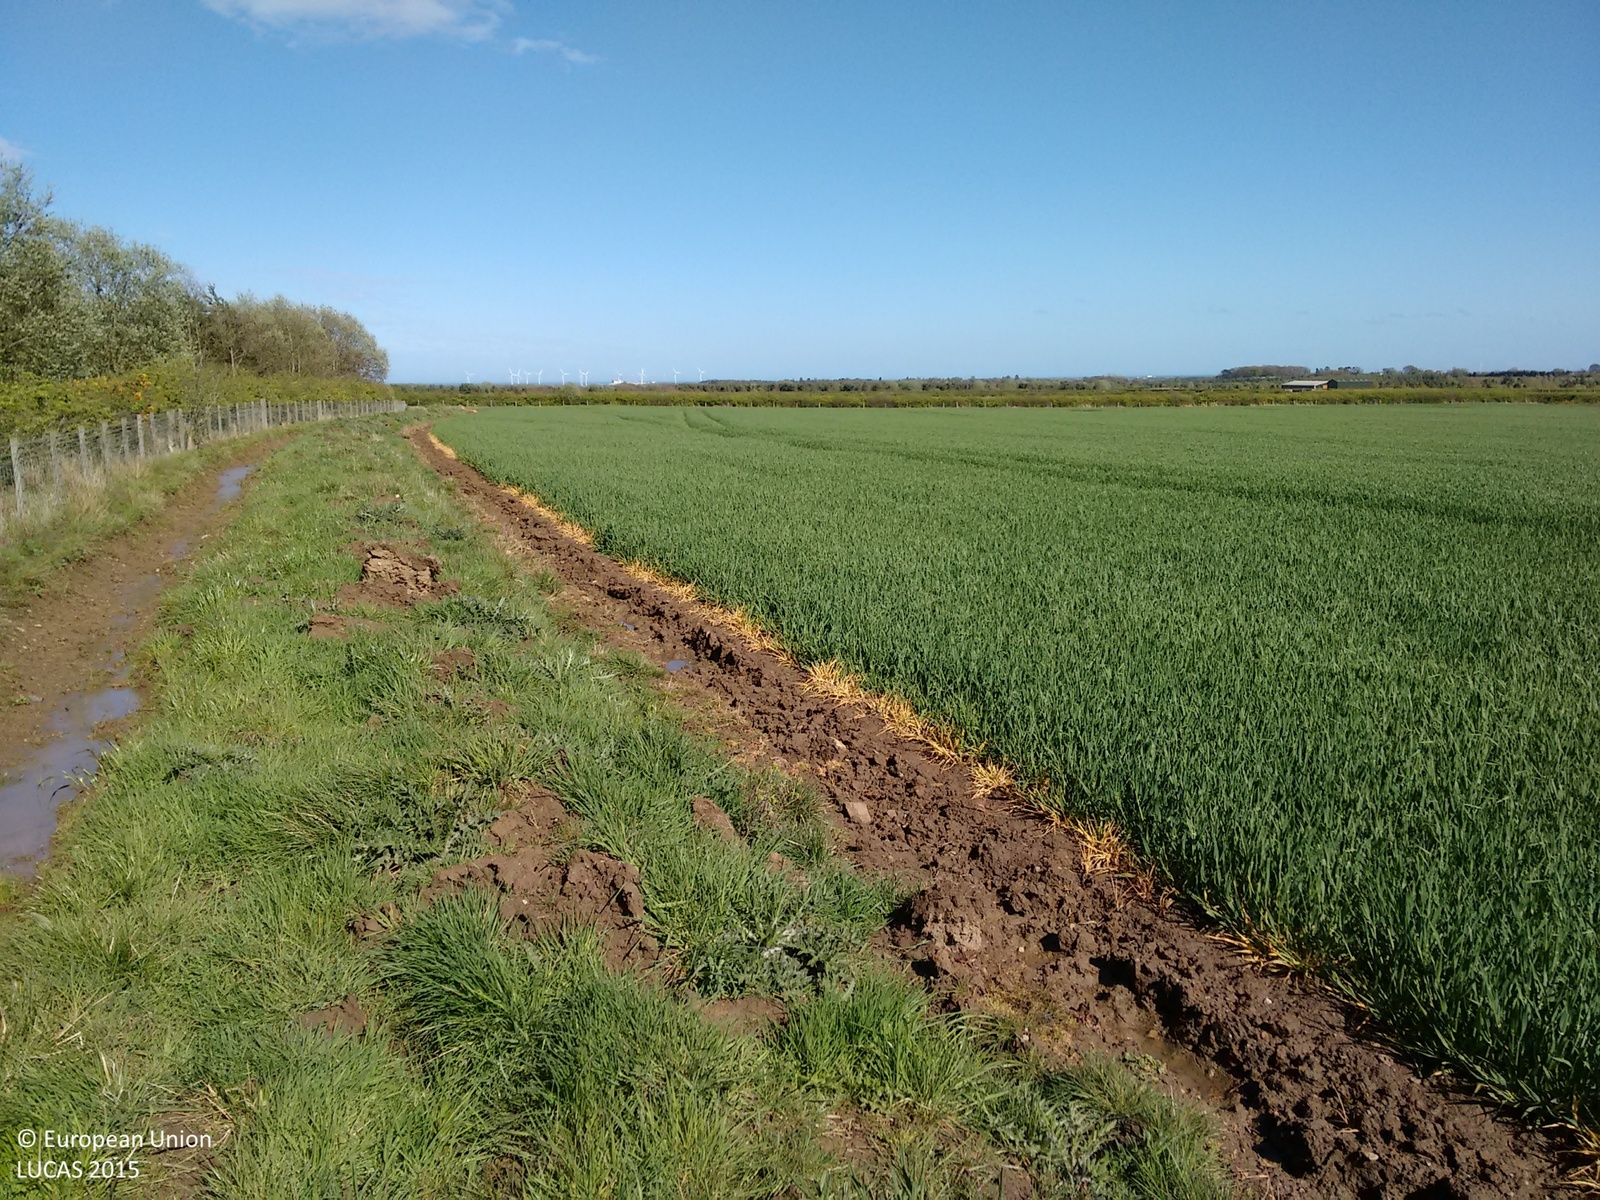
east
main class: Woodland
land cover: Pine dominated coniferous woodland
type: exotic forest
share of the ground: > 75 %
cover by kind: coniferous forest trees 100 %
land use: Forestry
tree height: > 5 m
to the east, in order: Pine dominated coniferous woodland; Shruby margins; Fences; Grass margins; Fences; Shruby margins; Fences; Grassland without tree/shrub cover; Barley
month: May
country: GB
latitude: 55.1966
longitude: -1.6905
